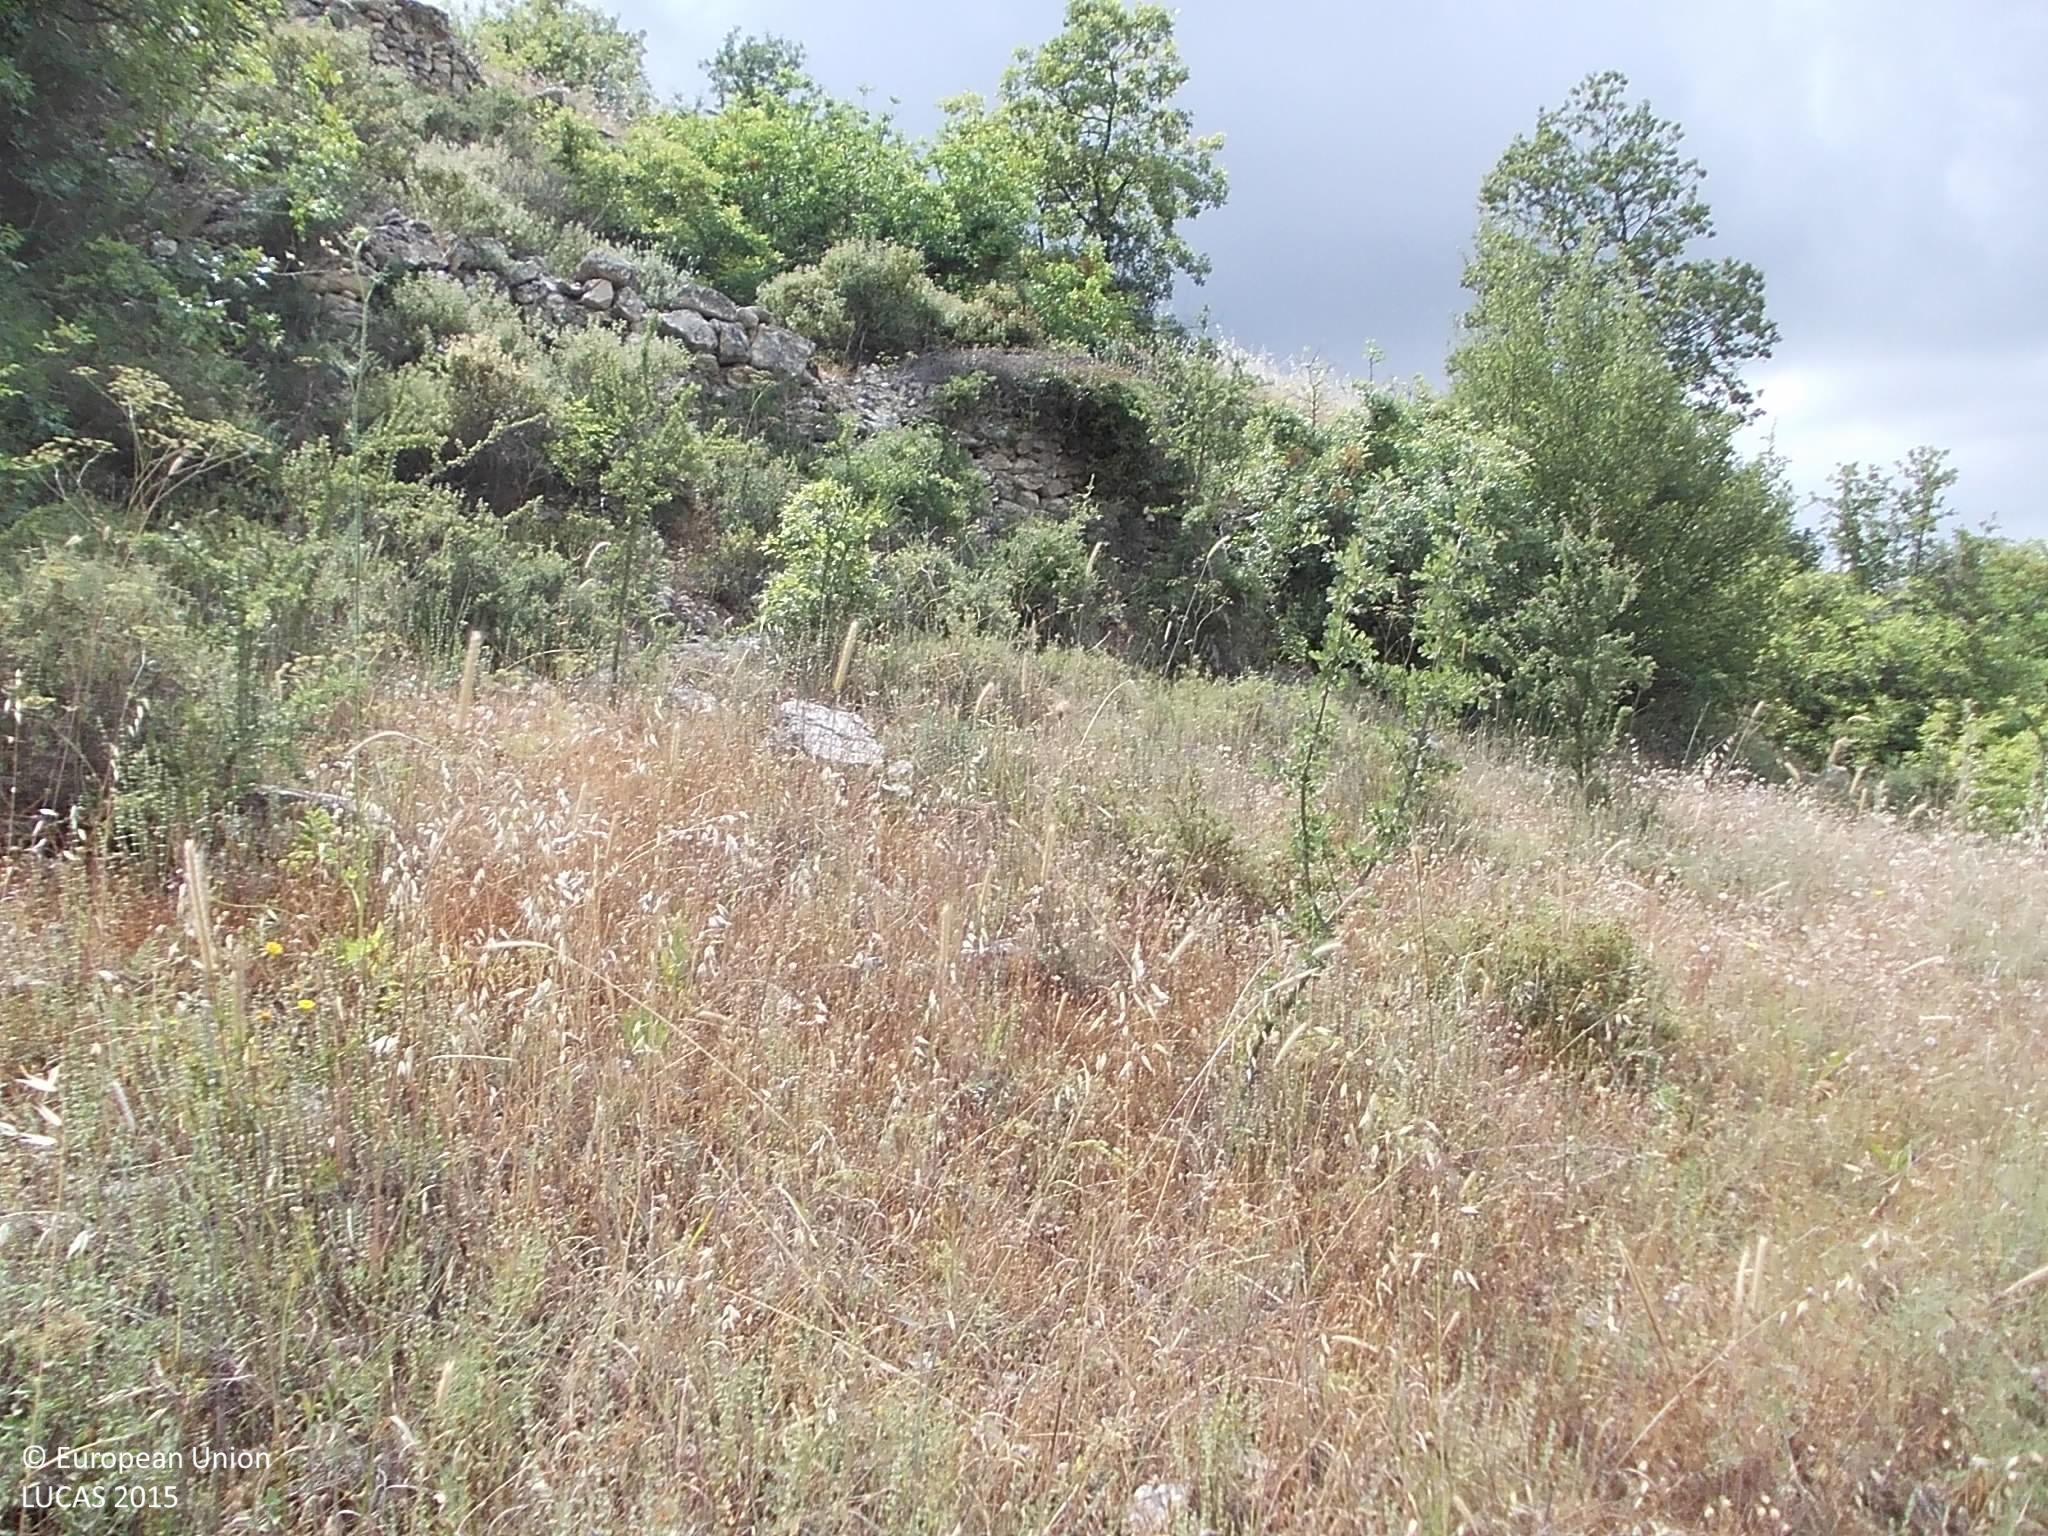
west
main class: Grassland
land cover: Grassland with sparse tree/shrub cover
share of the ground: > 75 %
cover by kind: herbaceous plants 85 %, broadleaved forest trees 5 %, shrubs 5 %, unconsolidated bare surface 5 %
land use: Abandoned areas
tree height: < 5 m
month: May
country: CY
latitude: 34.8078
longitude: 32.7983
